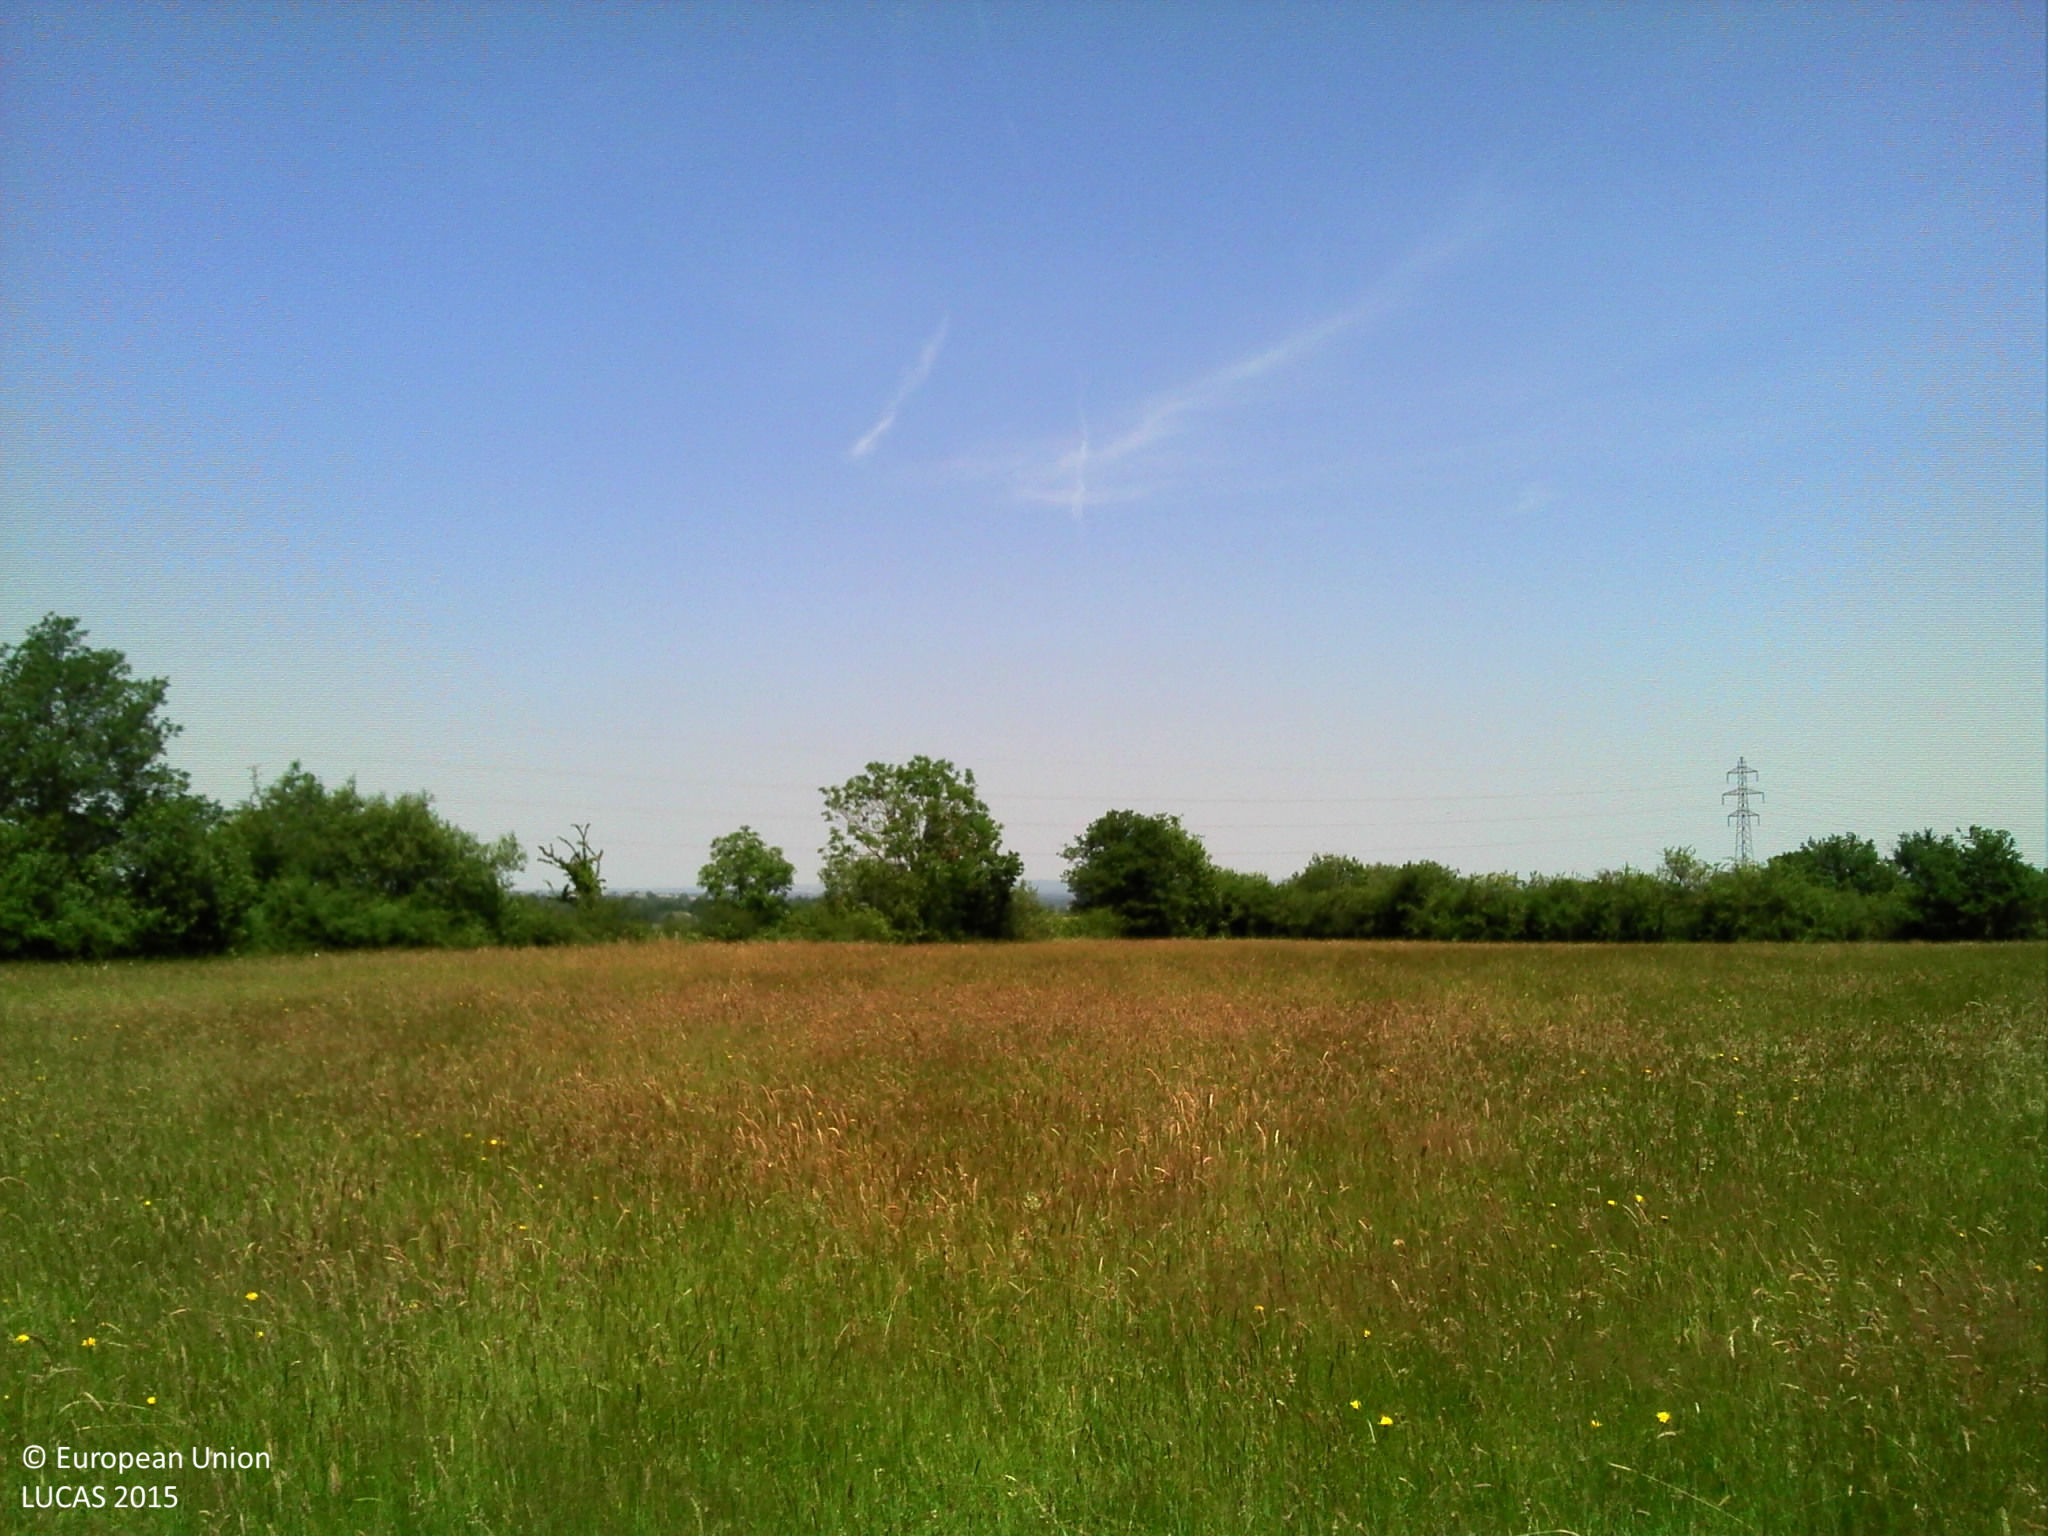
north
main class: Grassland
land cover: Grassland without tree/shrub cover
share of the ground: > 75 %
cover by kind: herbaceous plants 100 %
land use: Agriculture (excluding fallow land and kitchen gardens)
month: June
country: FR
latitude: 46.2888
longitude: 2.7930
